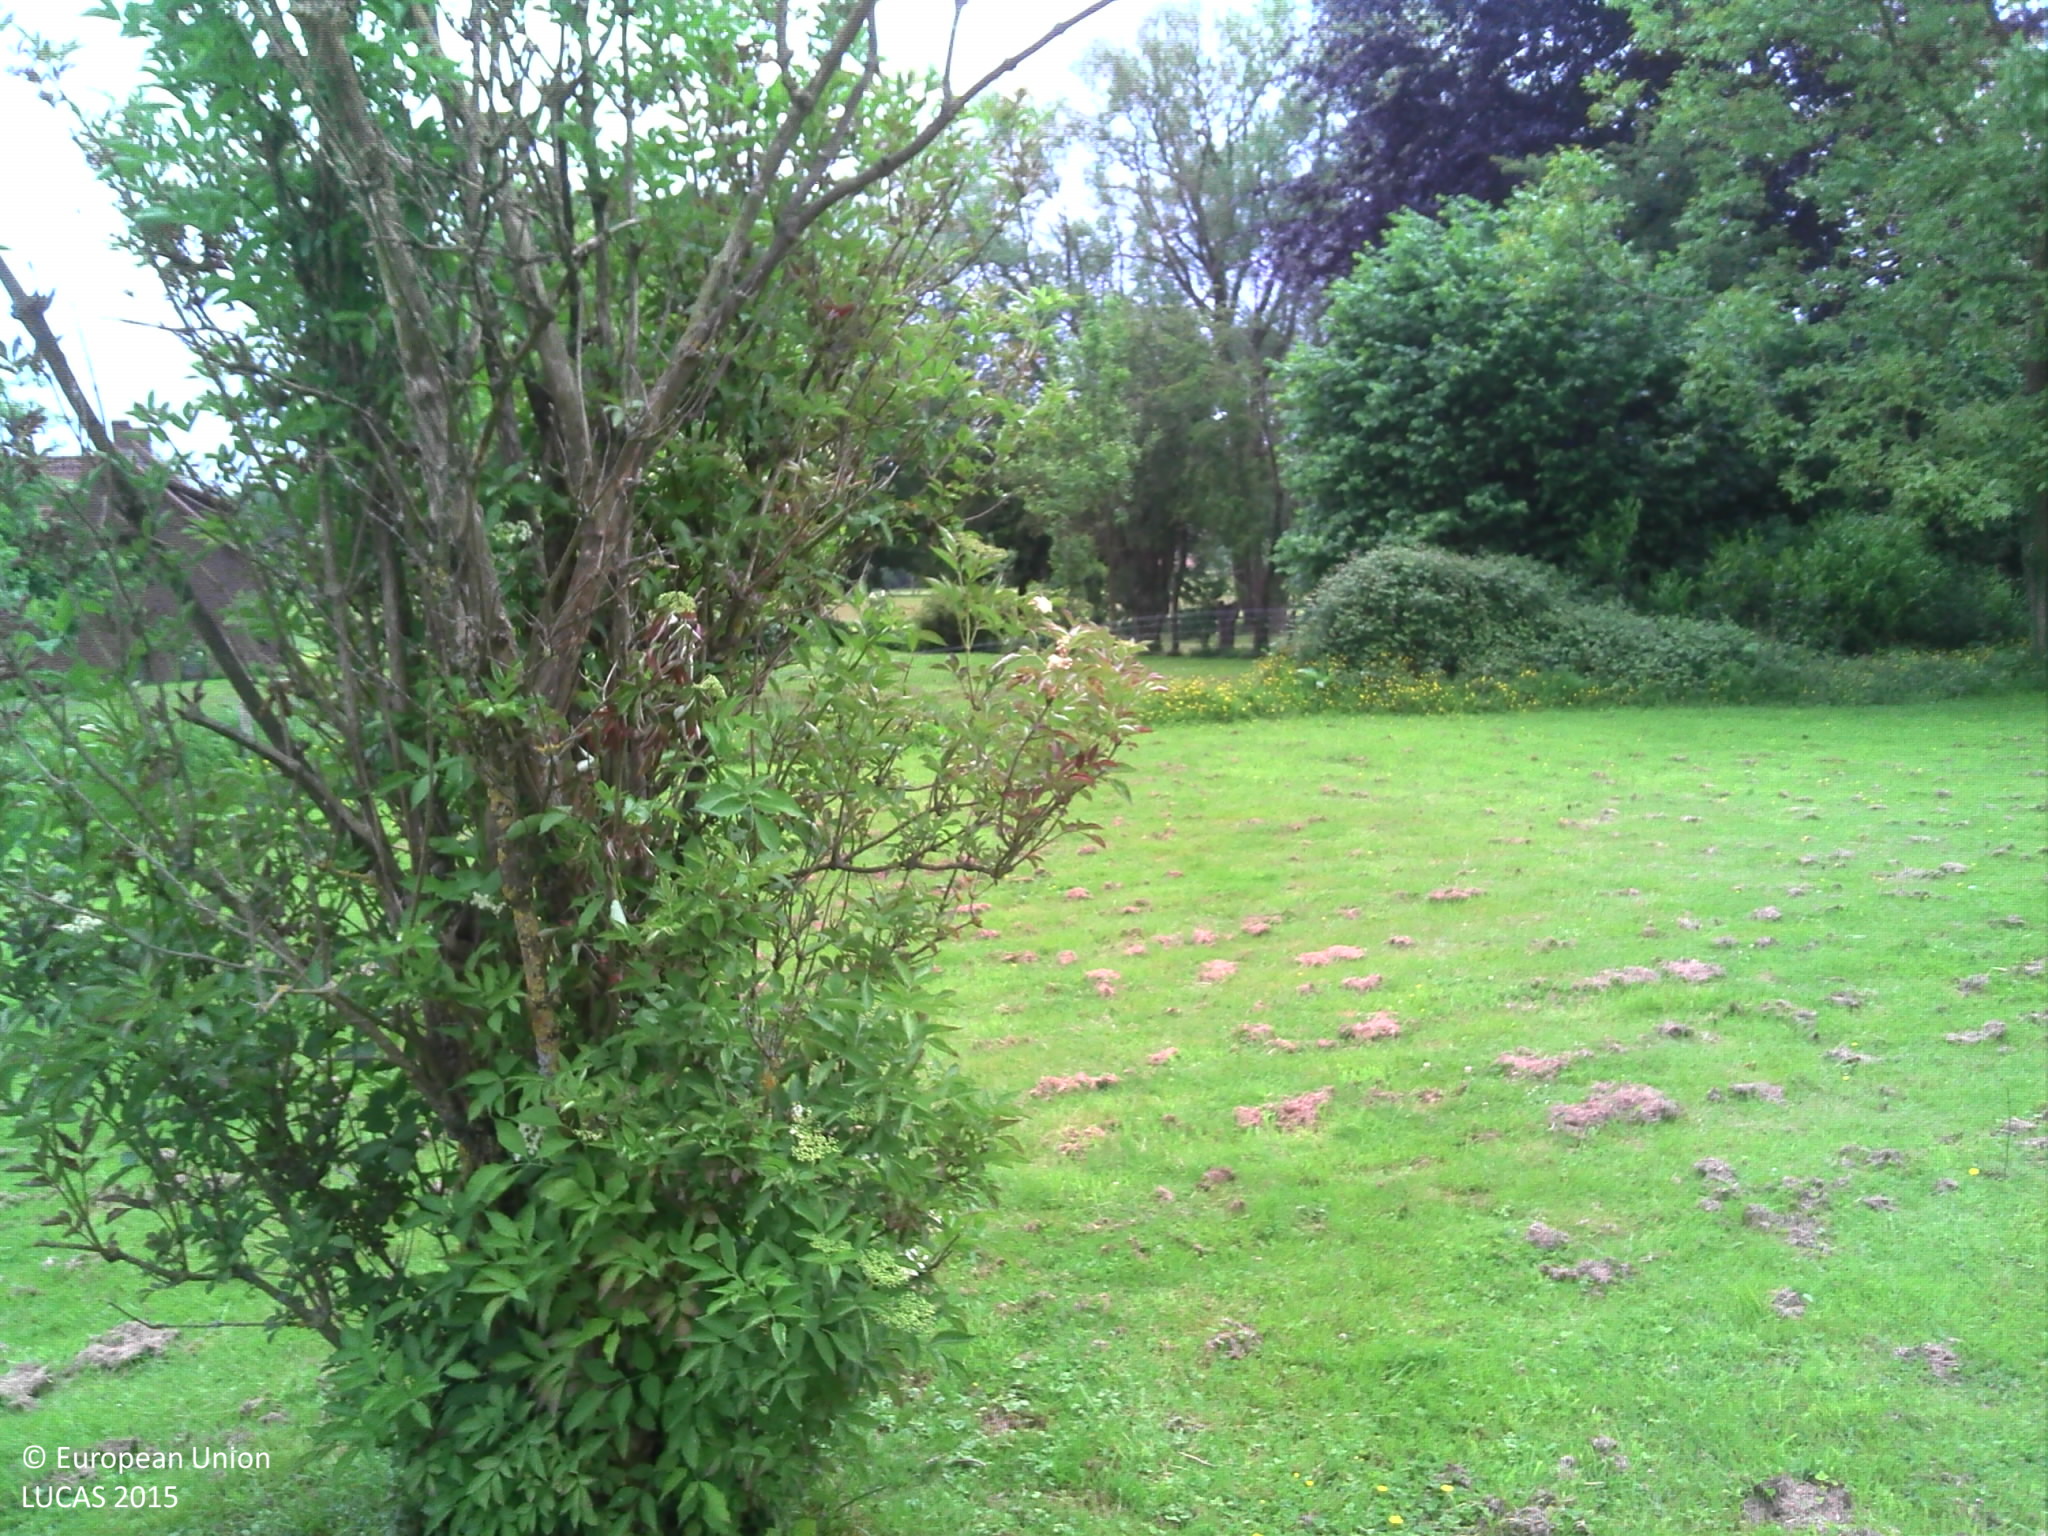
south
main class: Grassland
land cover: Grassland with sparse tree/shrub cover
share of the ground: > 75 %
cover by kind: herbaceous plants 95 %, broadleaved forest trees 5 %
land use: Agriculture (excluding fallow land and kitchen gardens)
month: June
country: BE
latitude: 50.8504
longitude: 3.9003
